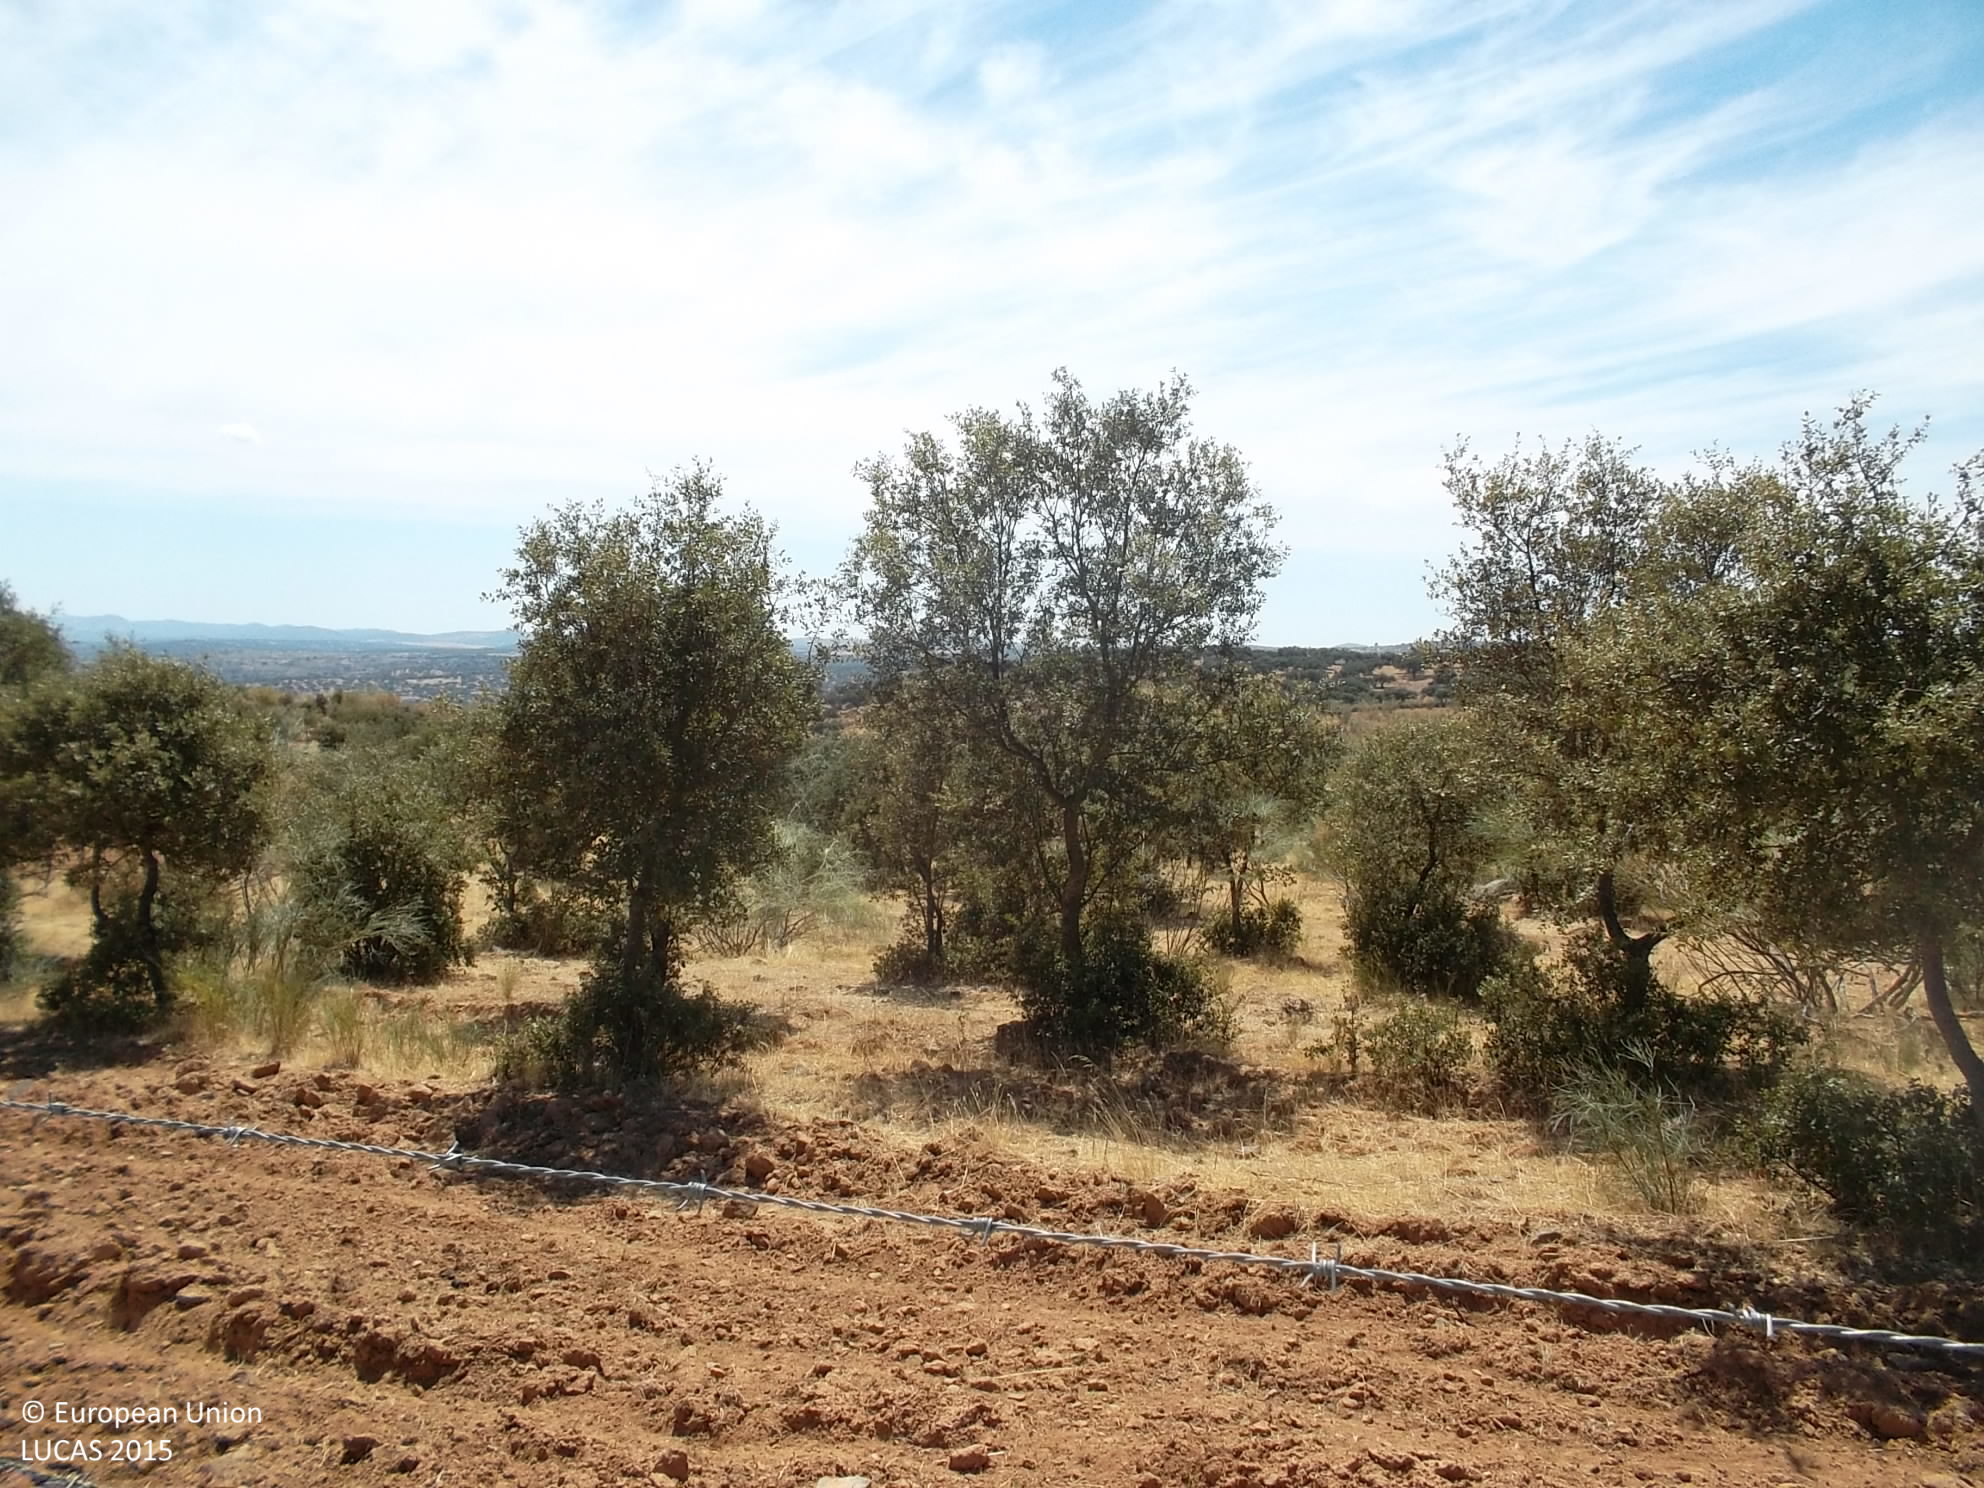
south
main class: Woodland
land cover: Broadleaved woodland
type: broadleaved evergreen forest
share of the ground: 25 - 50 %
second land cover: Grassland without tree/shrub cover
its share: > 75 %
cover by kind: herbaceous plants 70 %, broadleaved forest trees 30 %
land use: Forestry
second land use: Agriculture (excluding fallow land and kitchen gardens)
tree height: < 5 m
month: August
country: ES
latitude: 38.2368
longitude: -6.5819
